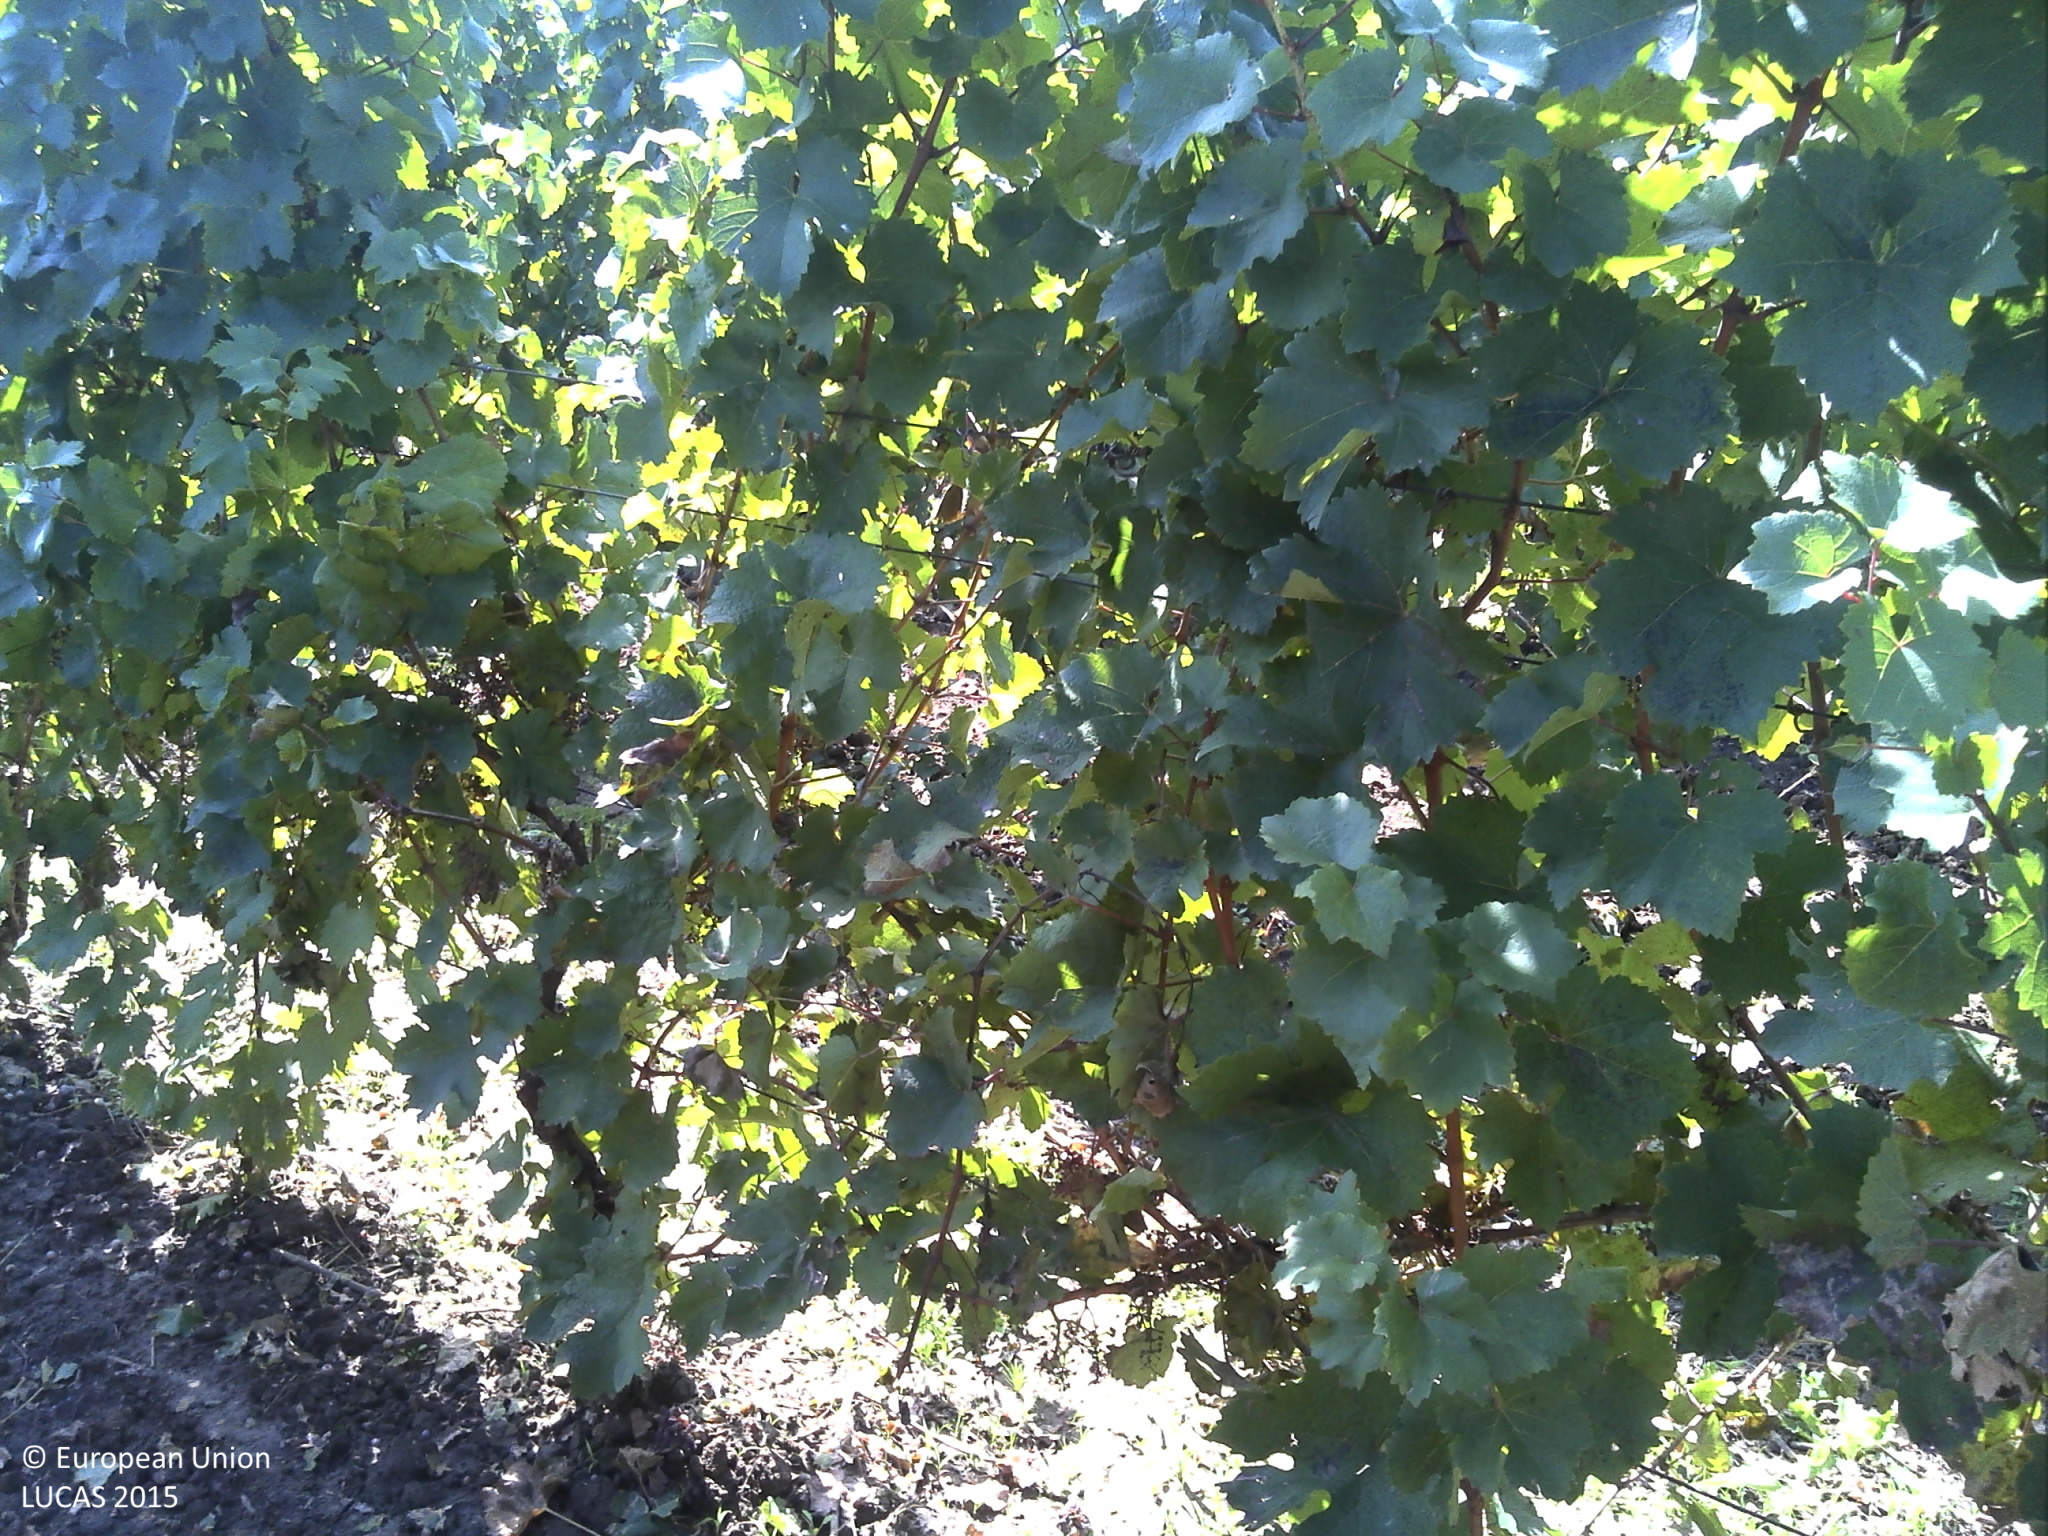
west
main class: Cropland
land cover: Vineyards
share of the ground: 10 - 25 %
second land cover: Other bare soil
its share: > 75 %
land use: Agriculture (excluding fallow land and kitchen gardens)
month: September
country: HR
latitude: 45.3321
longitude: 19.0557
